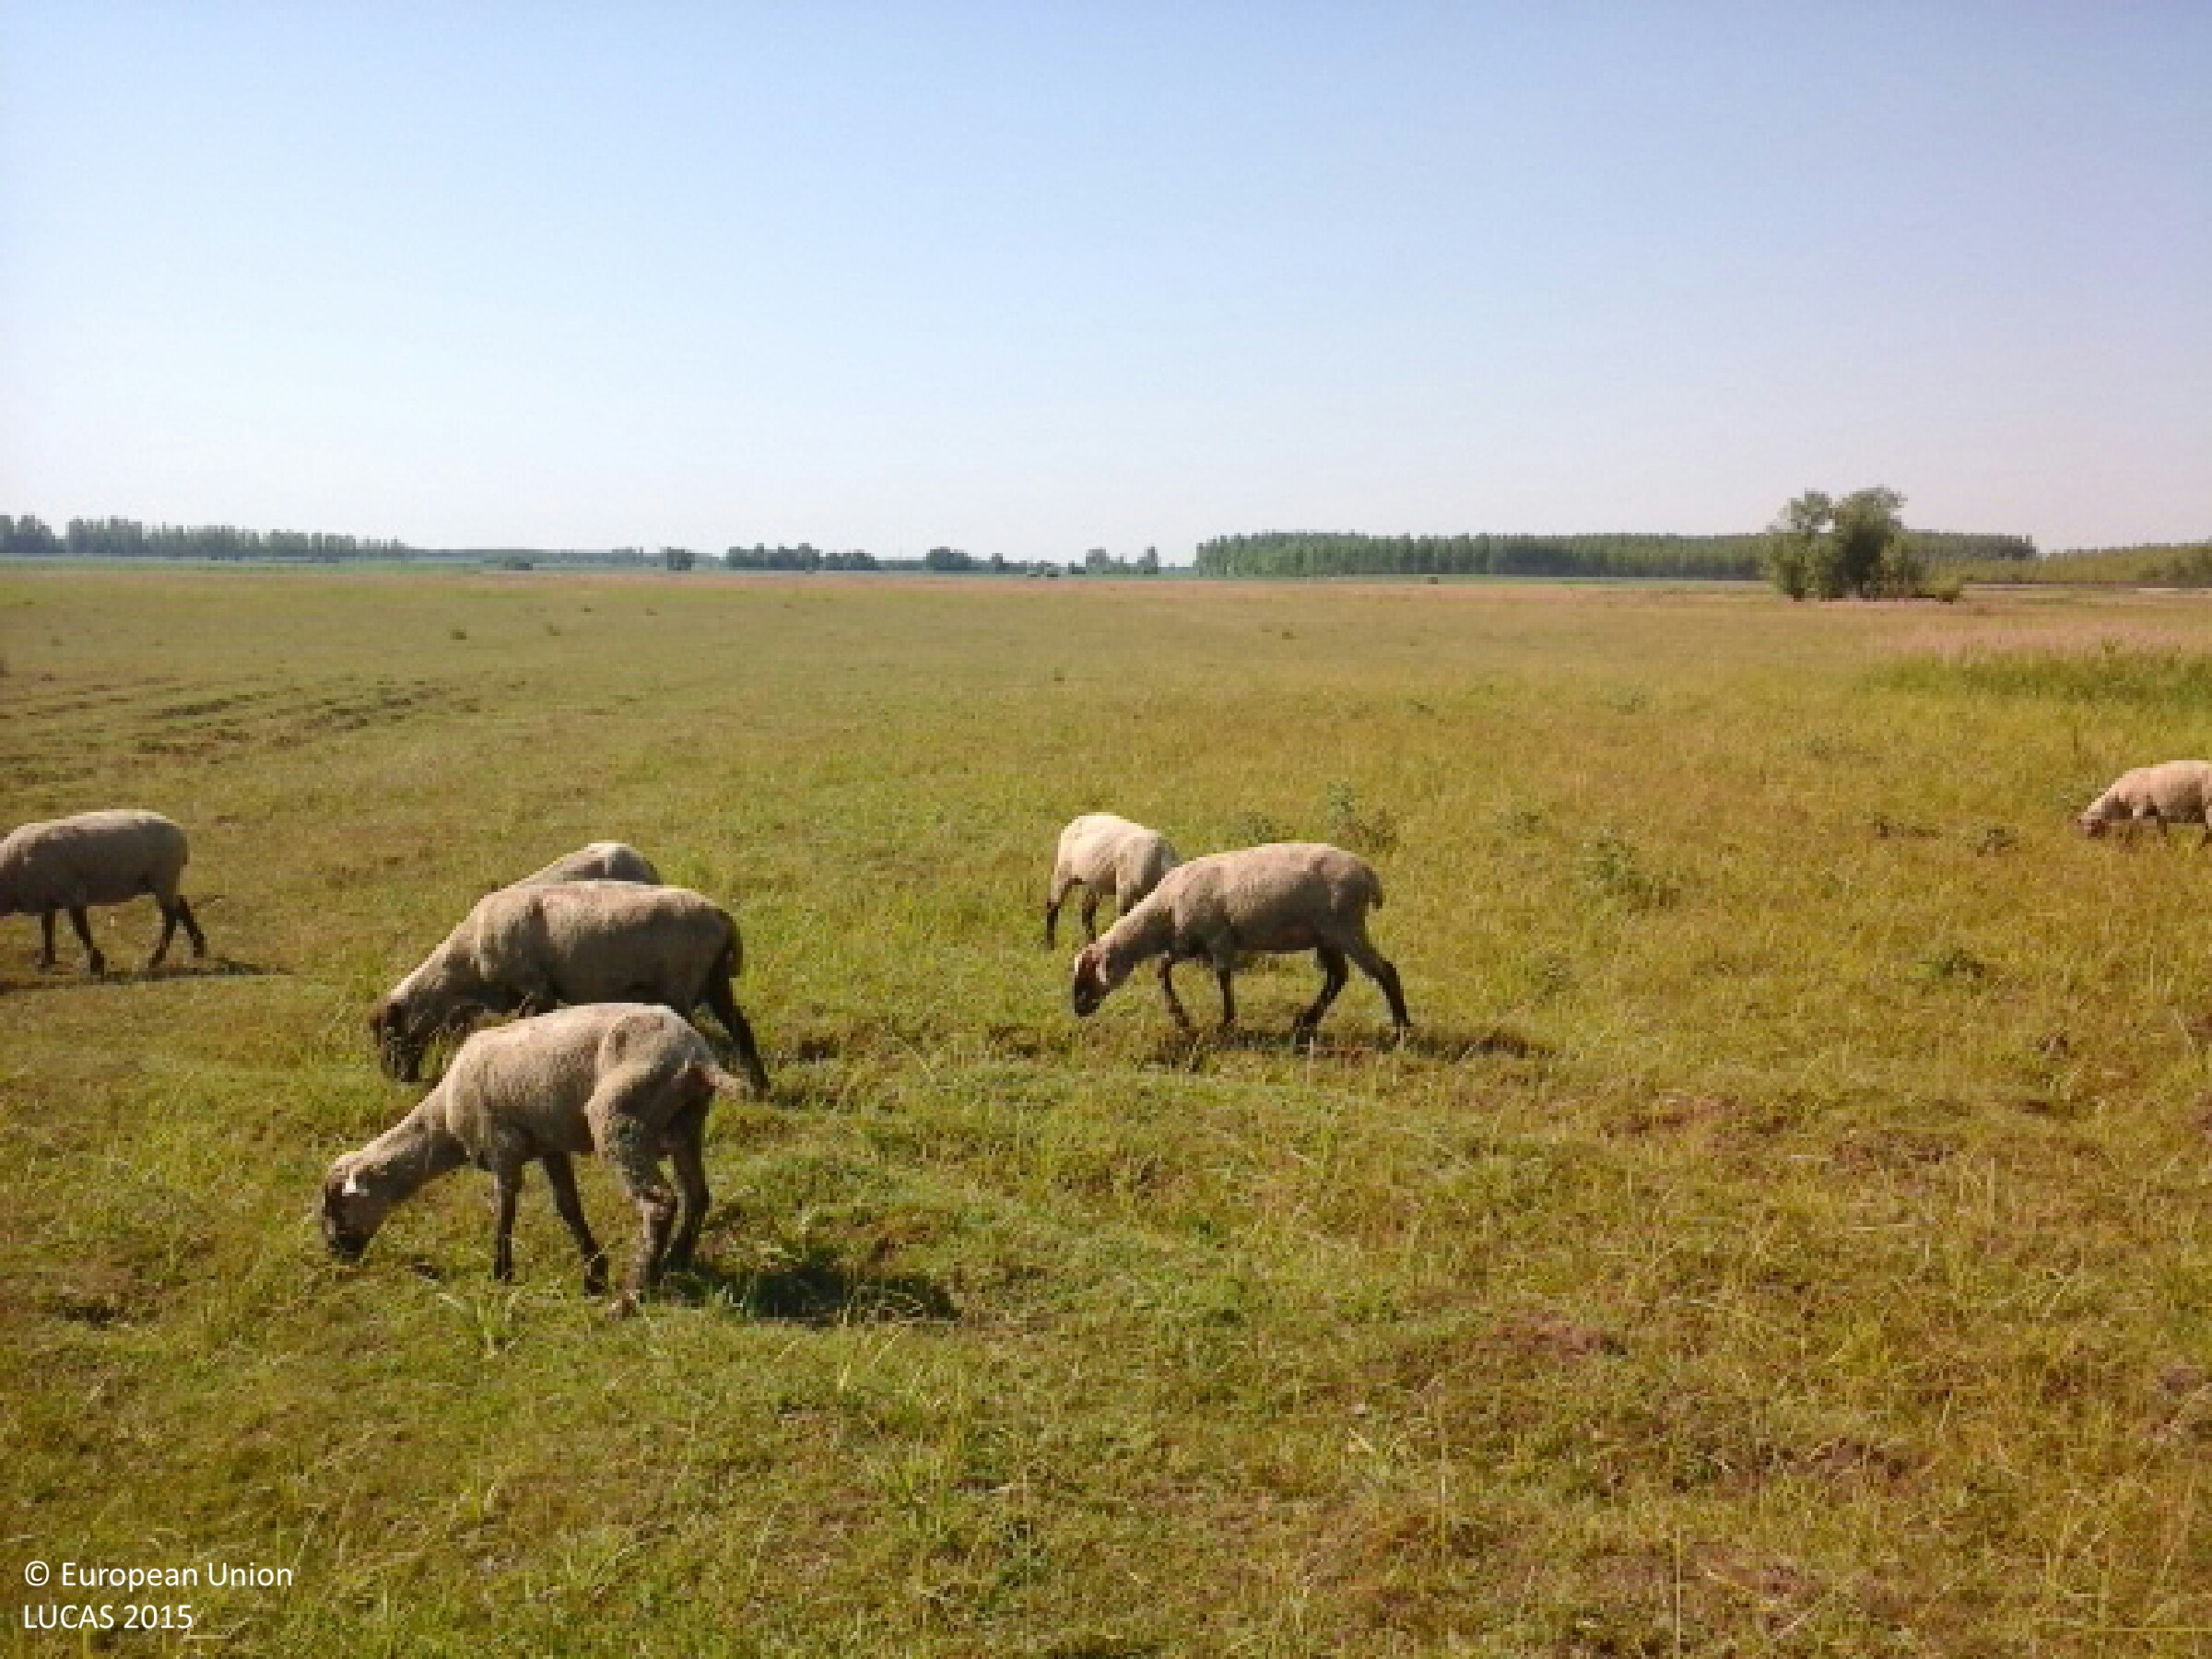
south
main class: Grassland
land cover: Grassland without tree/shrub cover
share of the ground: > 75 %
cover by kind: herbaceous plants 100 %
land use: Abandoned areas
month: June
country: HU
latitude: 47.7745
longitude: 21.7508
